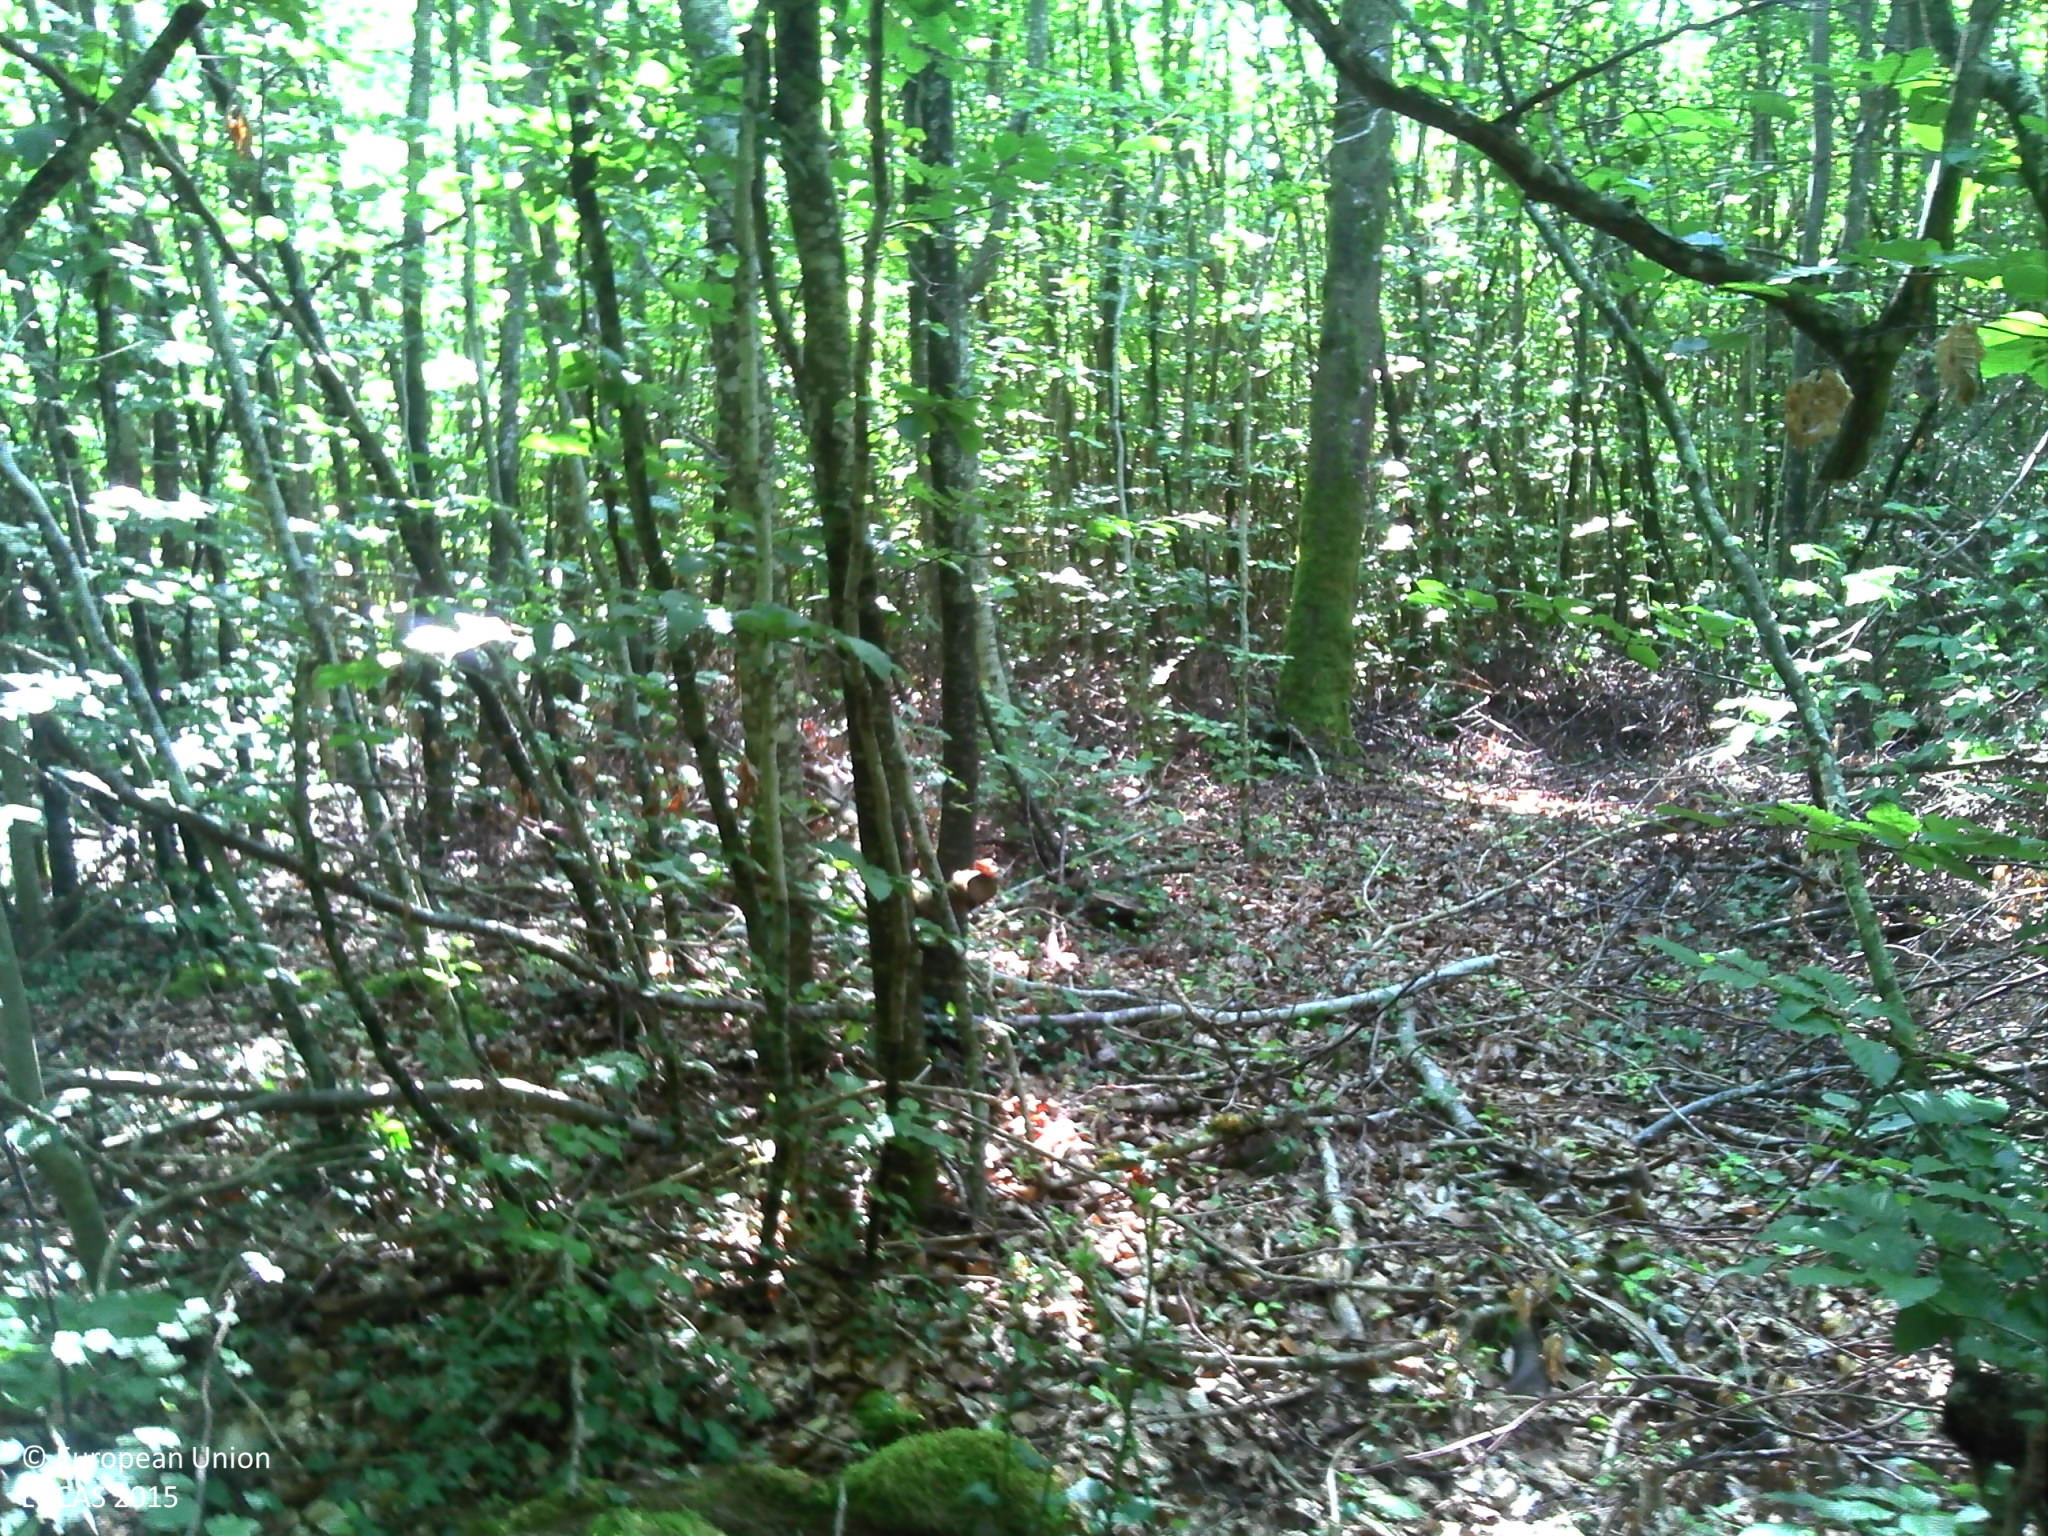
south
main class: Woodland
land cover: Broadleaved woodland
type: beech forest
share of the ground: > 75 %
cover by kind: broadleaved forest trees 90 %, herbaceous plants 5 %, consolidated bare surface 5 %
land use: Forestry
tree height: > 5 m
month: September
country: FR
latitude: 48.5635
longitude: 5.9482
